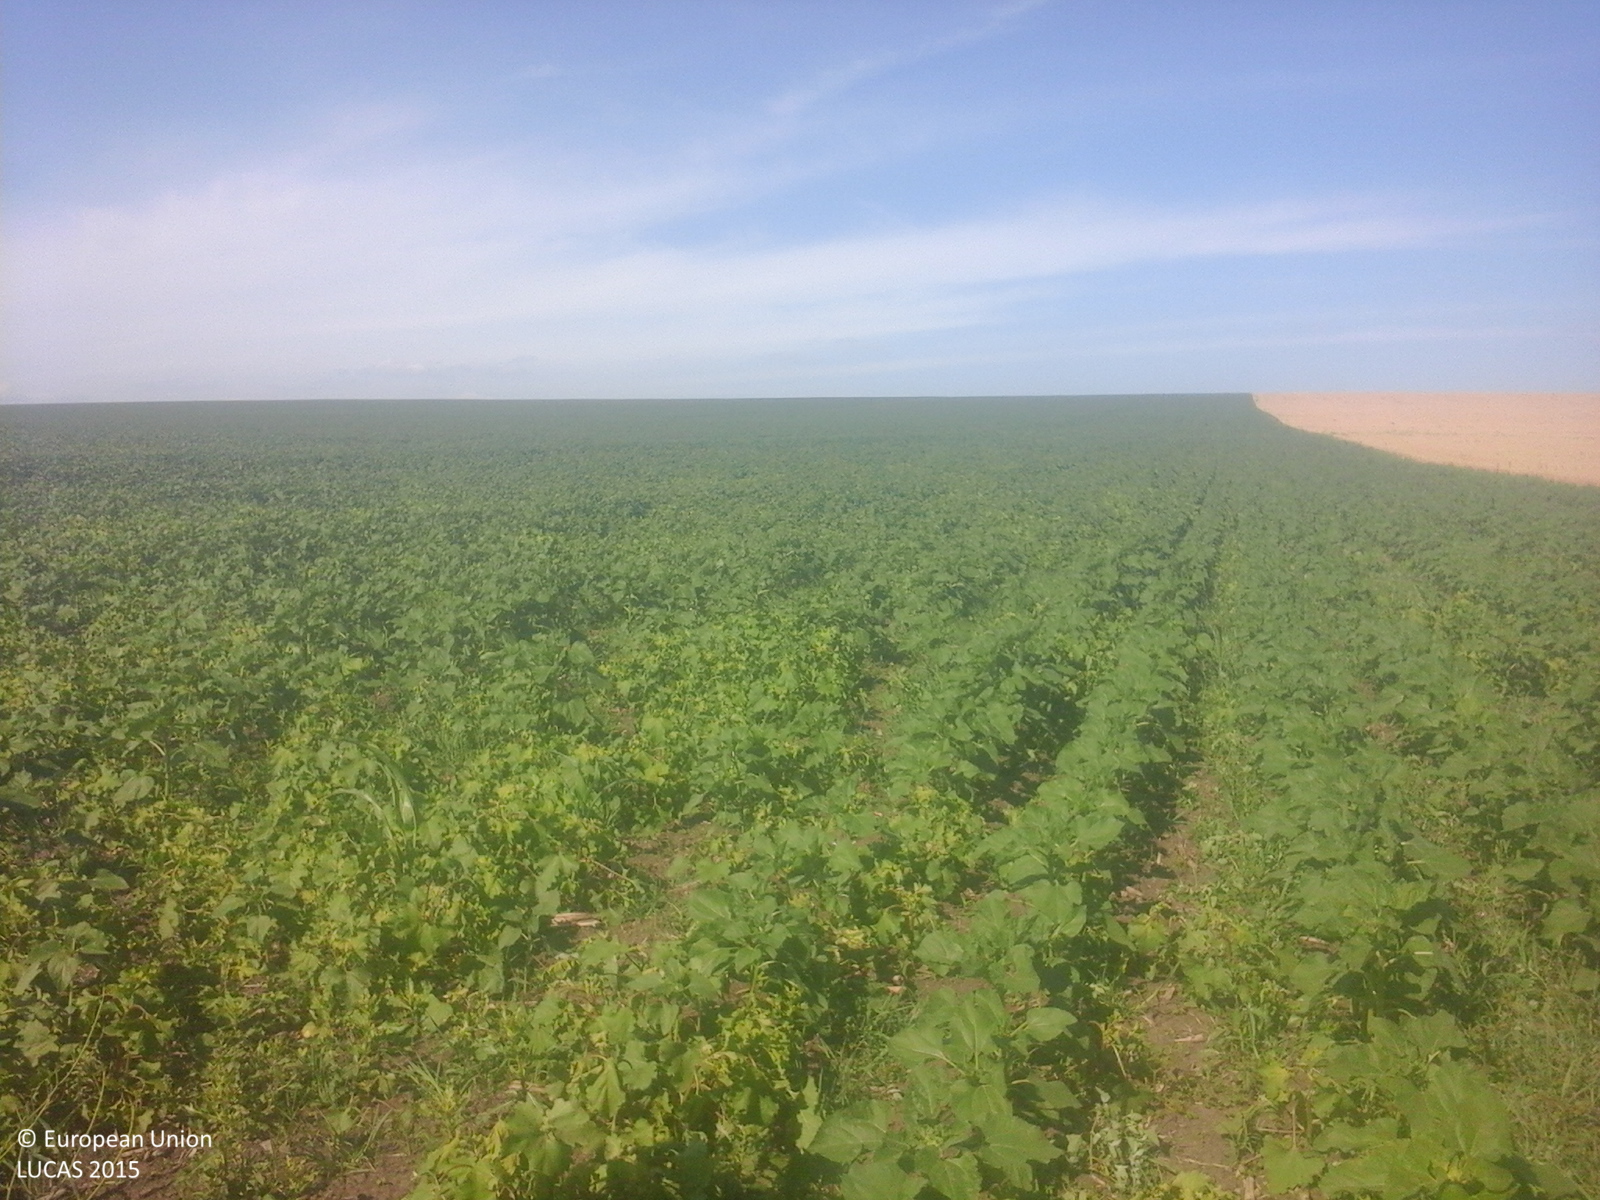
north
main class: Cropland
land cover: Sunflower
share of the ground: 50 - 75 %
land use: Agriculture (excluding fallow land and kitchen gardens)
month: June
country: RO
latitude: 47.9577
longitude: 26.9929
